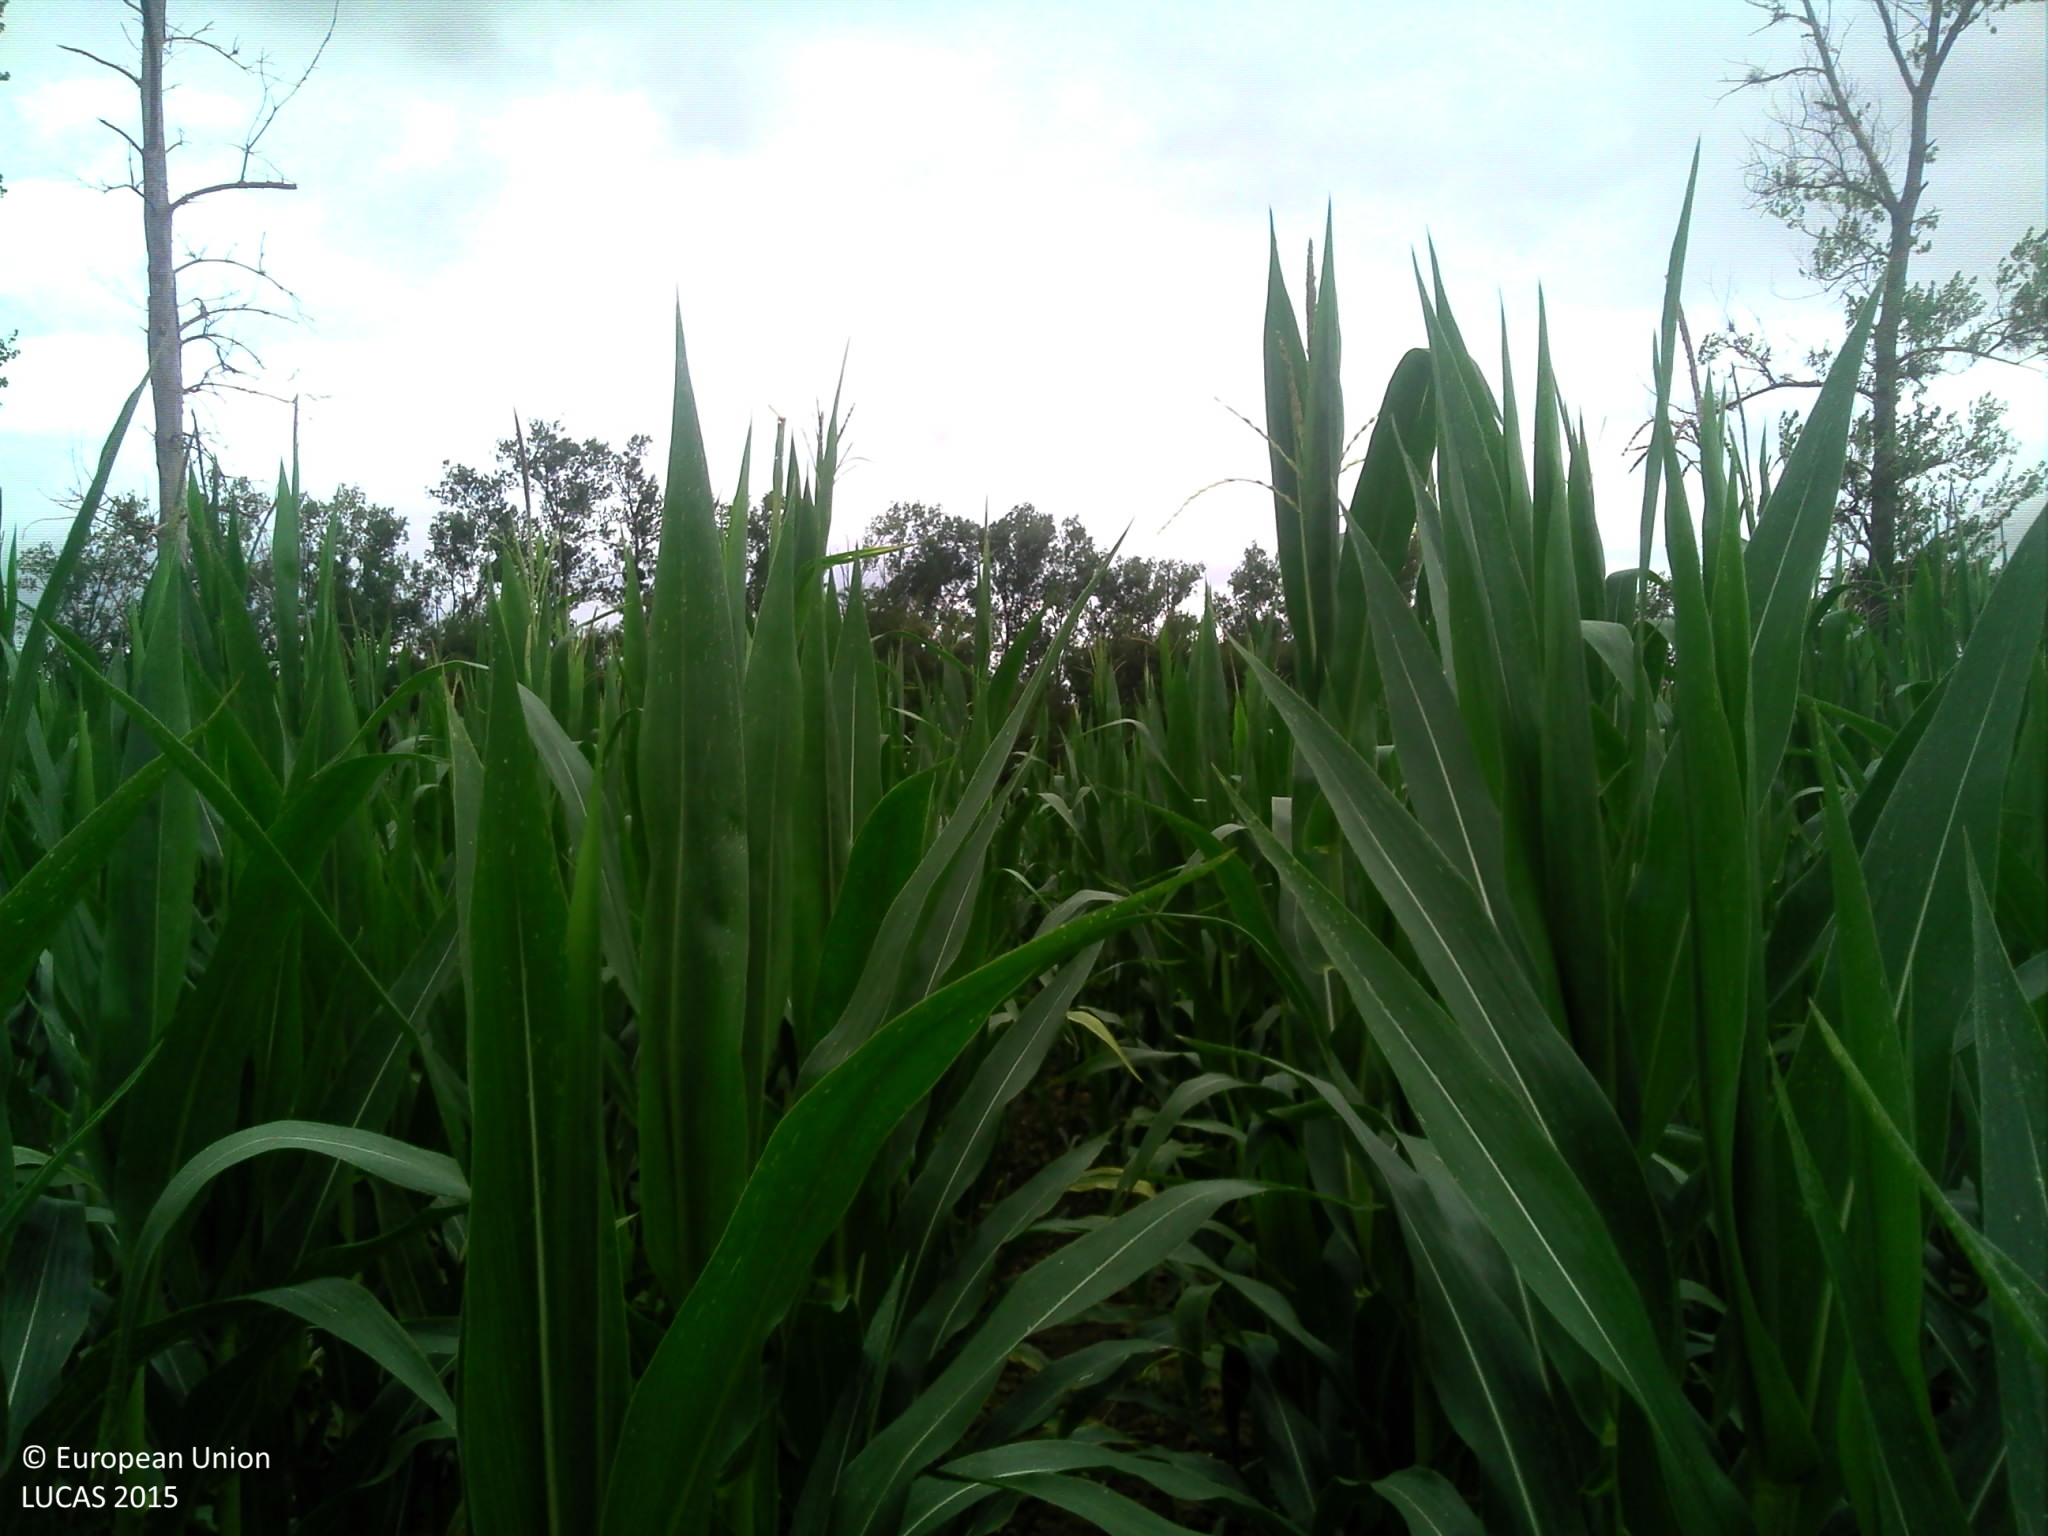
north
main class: Cropland
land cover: Maize
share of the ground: > 75 %
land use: Agriculture (excluding fallow land and kitchen gardens)
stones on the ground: < 10 %
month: July
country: FR
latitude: 43.2559
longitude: 0.8494
